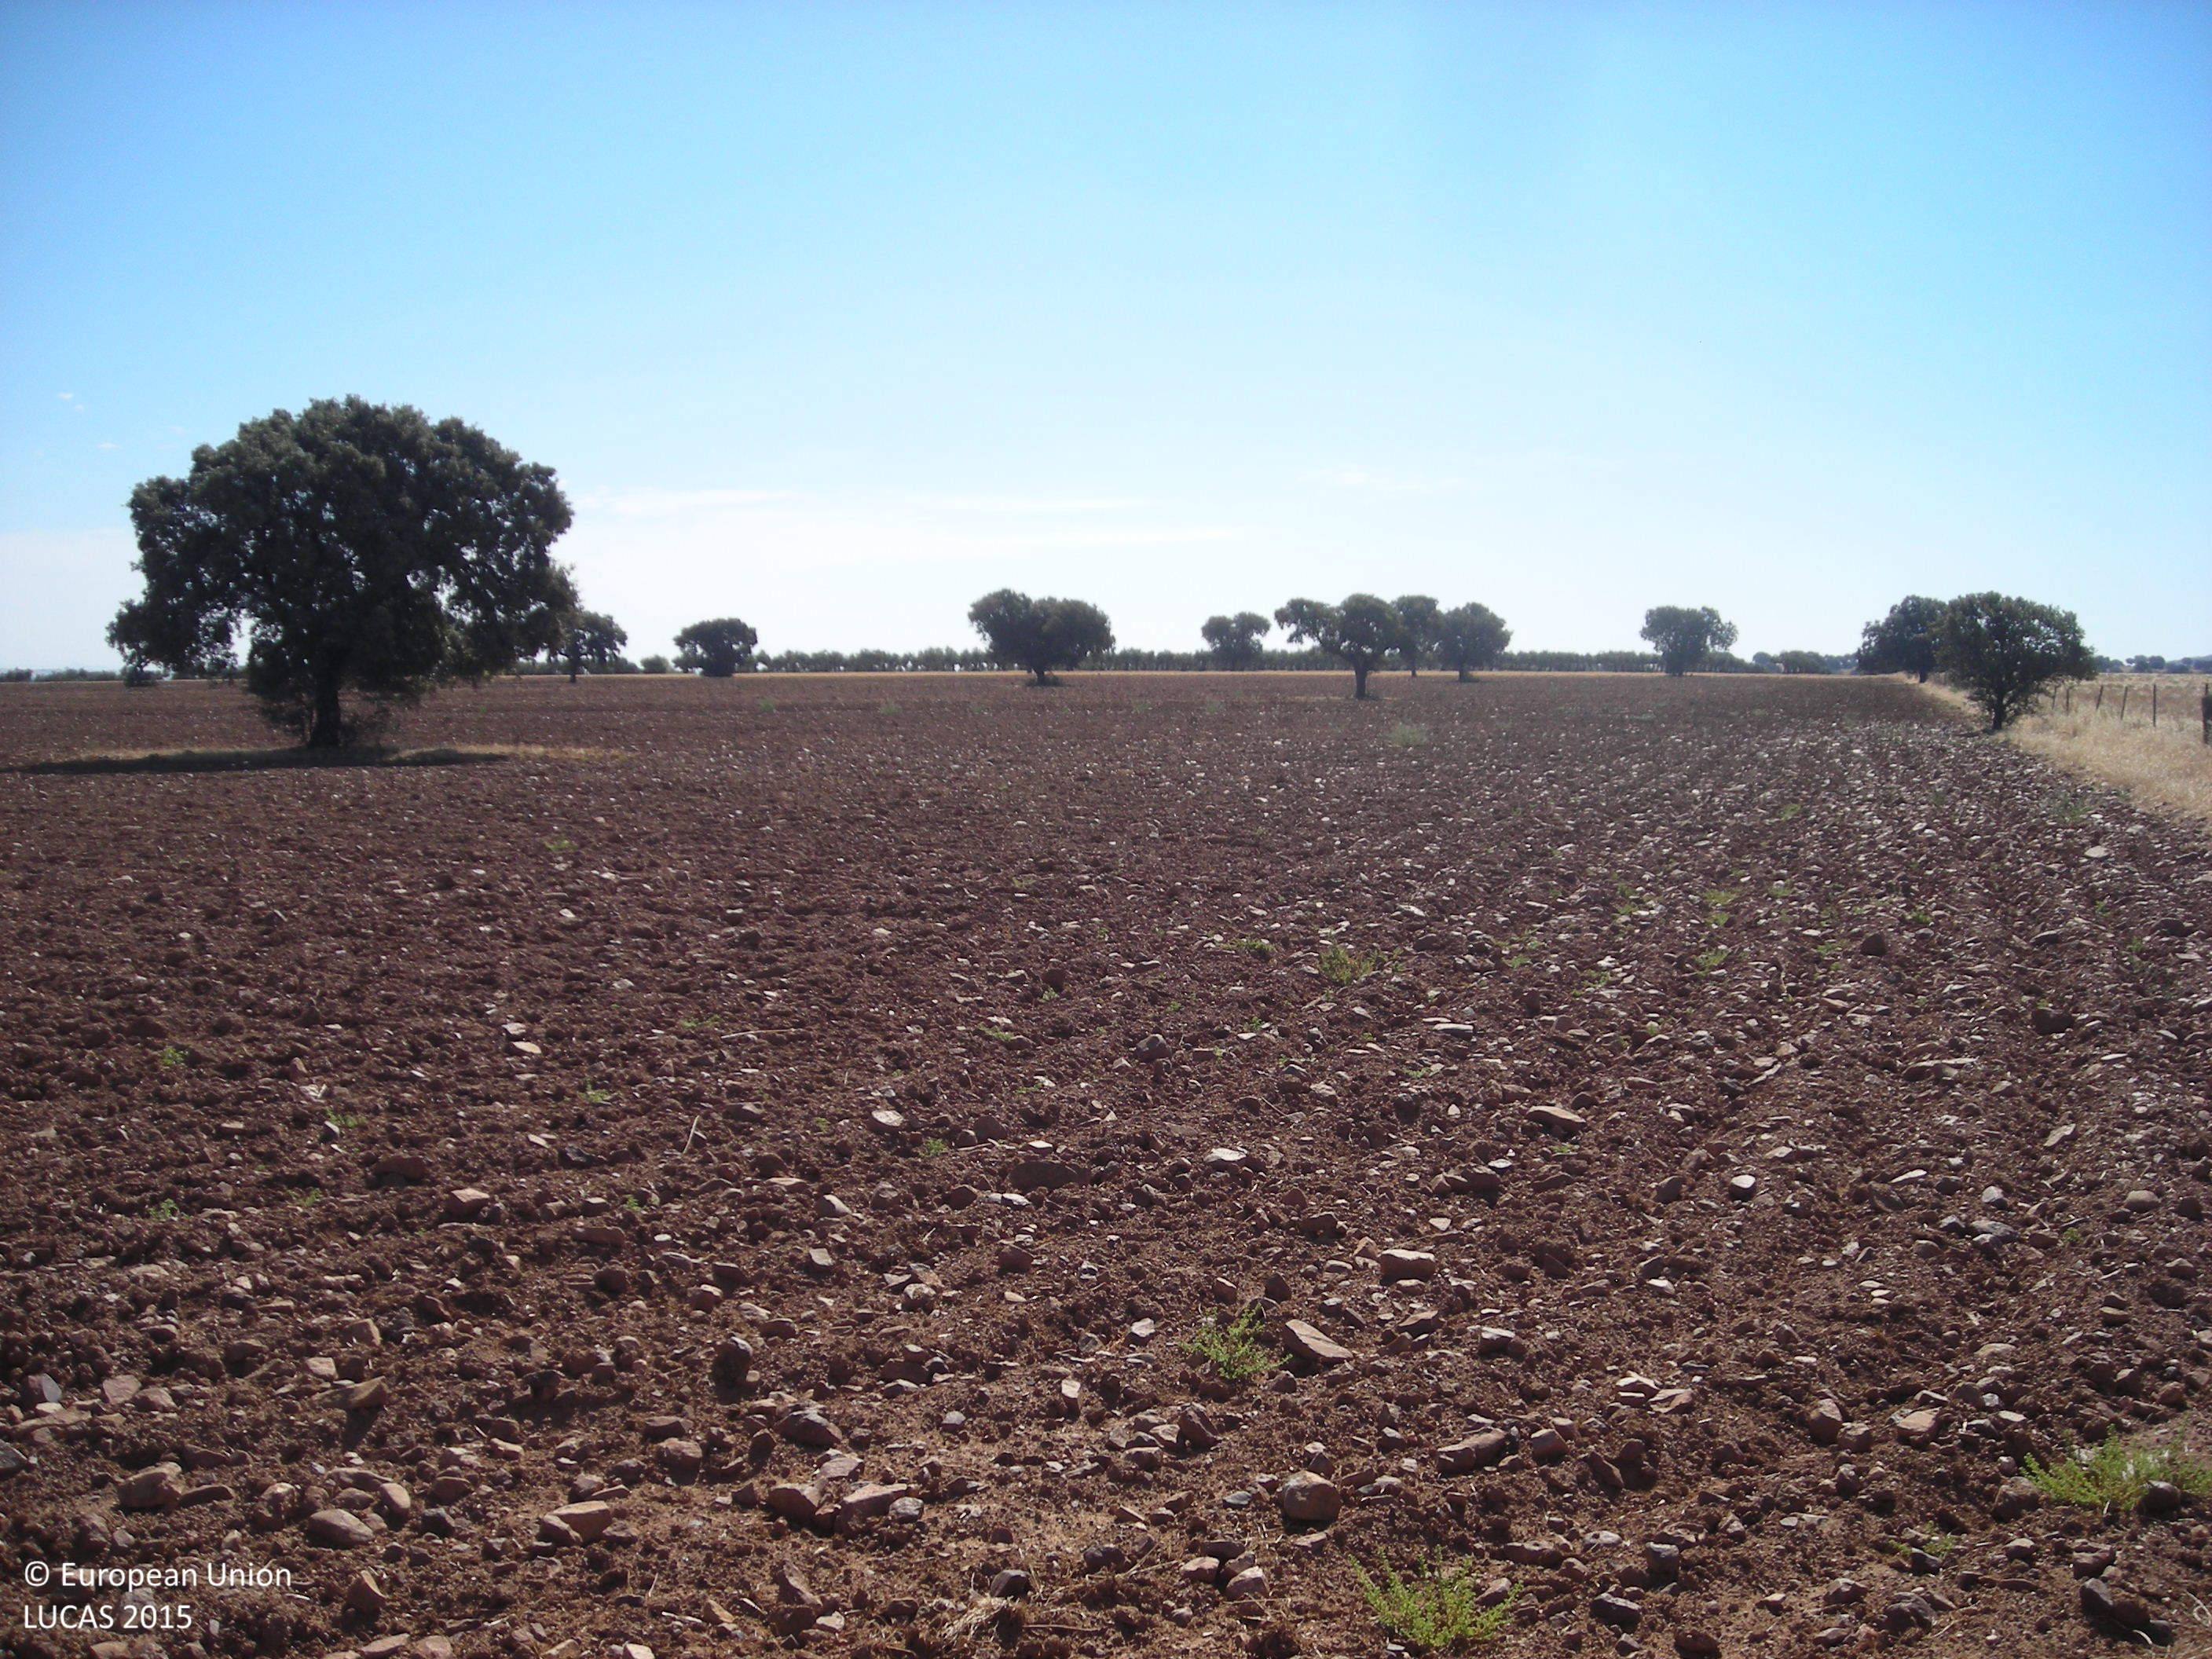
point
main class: Cropland
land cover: Olive groves
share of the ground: 10 - 25 %
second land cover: Other bare soil
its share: > 75 %
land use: Agriculture (excluding fallow land and kitchen gardens)
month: July
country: ES
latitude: 38.8244
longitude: -5.8382
